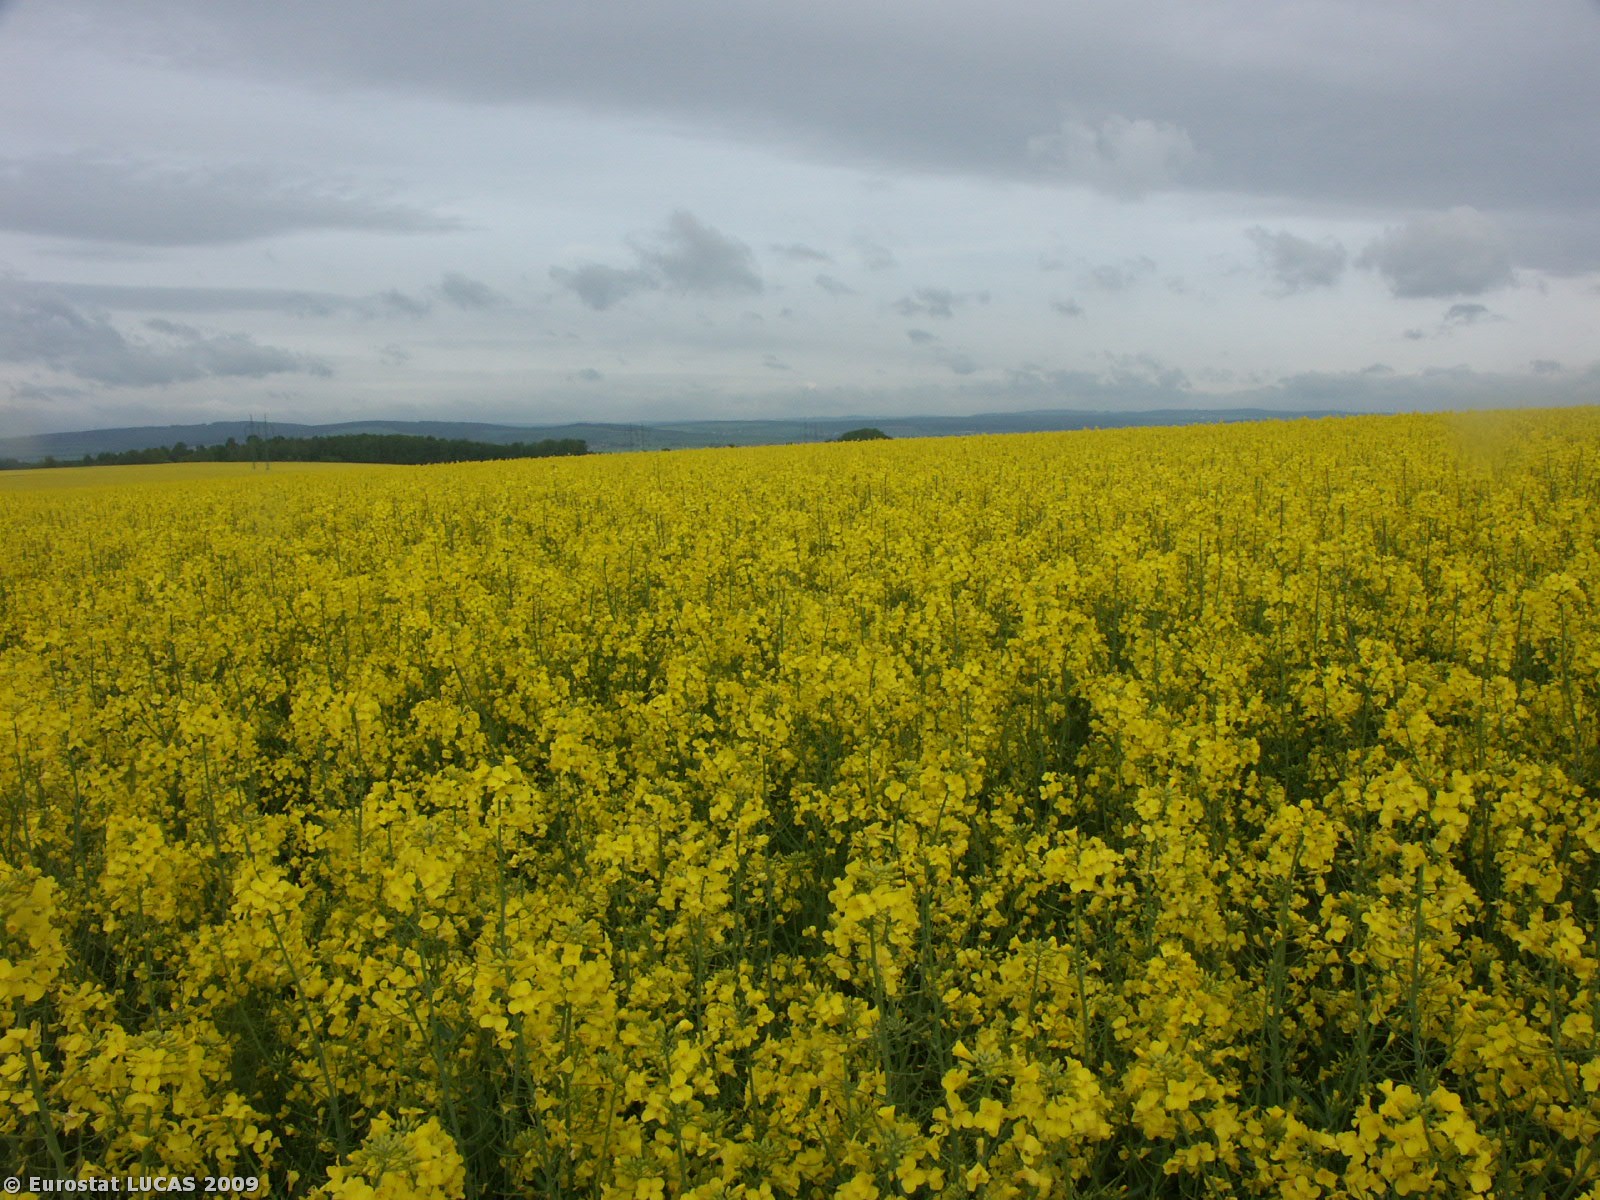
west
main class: Cropland
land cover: Rape and turnip rape
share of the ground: > 75 %
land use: Agriculture (excluding fallow land and kitchen gardens)
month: May
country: CZ
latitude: 49.5602
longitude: 17.1856
